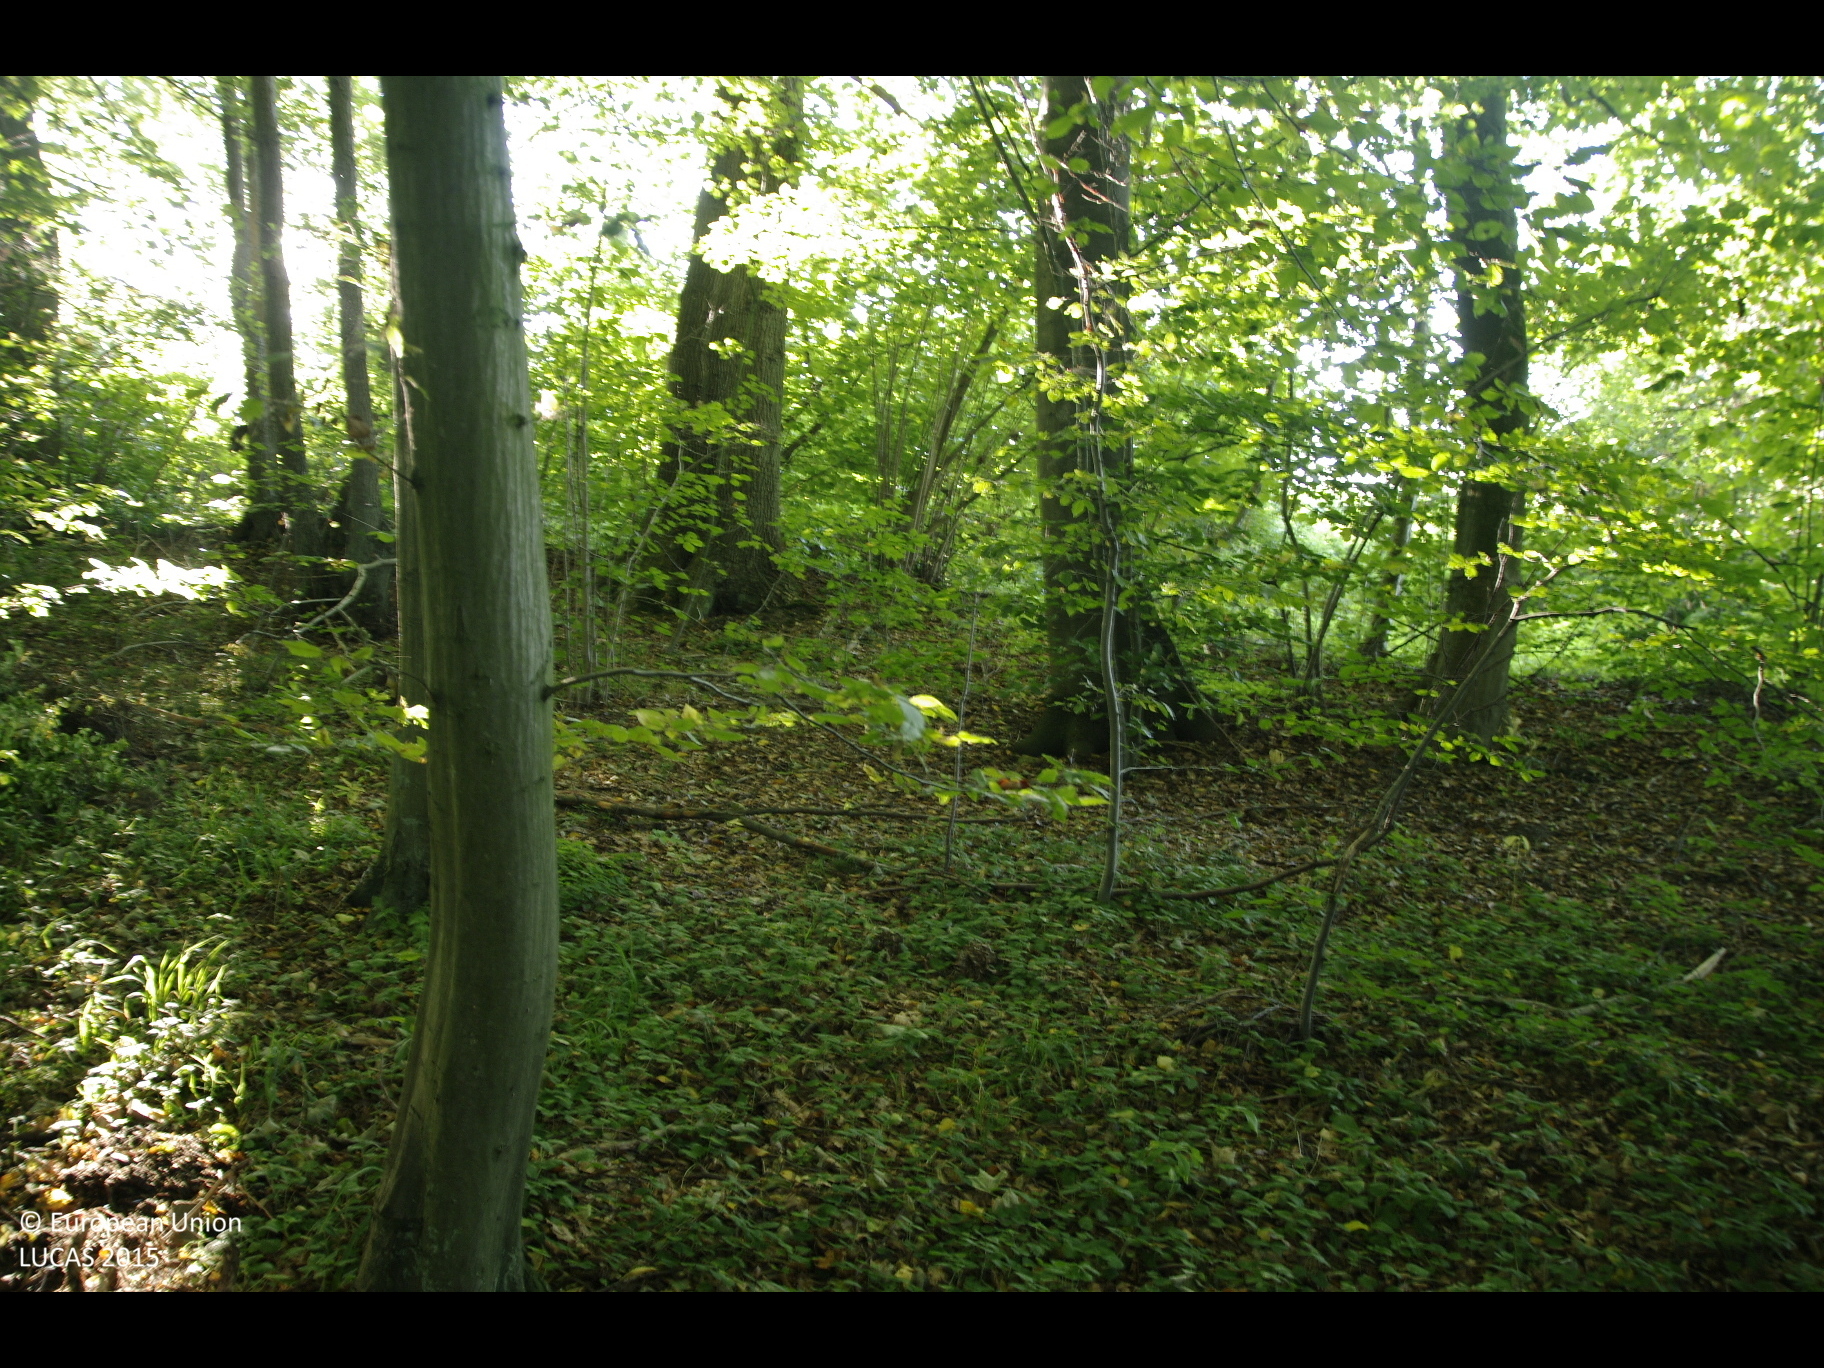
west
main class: Woodland
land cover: Broadleaved woodland
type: mesophytic deciduous forest
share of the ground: > 75 %
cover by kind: broadleaved forest trees 90 %, herbaceous plants 10 %
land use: Semi-natural and natural areas not in use
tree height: > 5 m
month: October
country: DE
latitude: 53.5082
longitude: 10.6179
